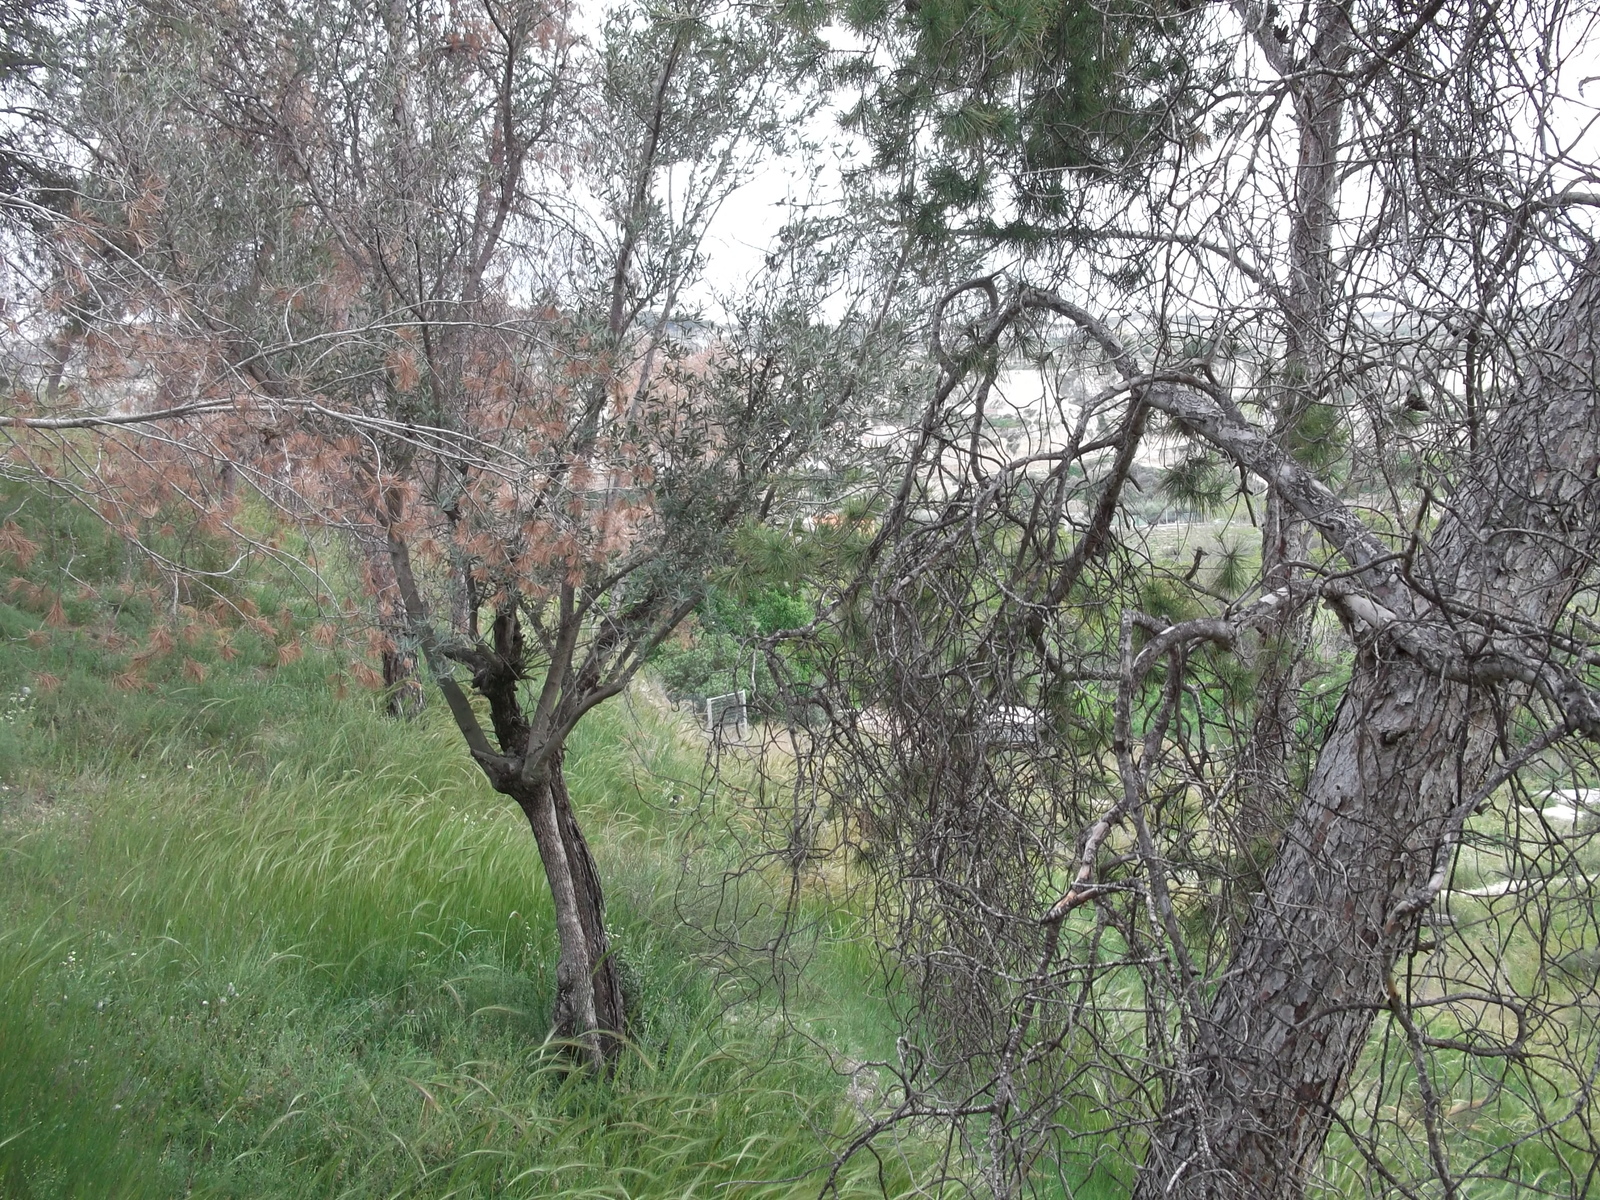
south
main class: Woodland
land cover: Pine dominated mixed woodland
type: coniferous forest of the mediterranean region
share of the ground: 25 - 50 %
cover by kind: consolidated bare surface 50 %, coniferous forest trees 25 %, broadleaved forest trees 25 %
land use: Semi-natural and natural areas not in use
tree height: > 5 m
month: April
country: ES
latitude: 38.0304
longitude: -1.3897
